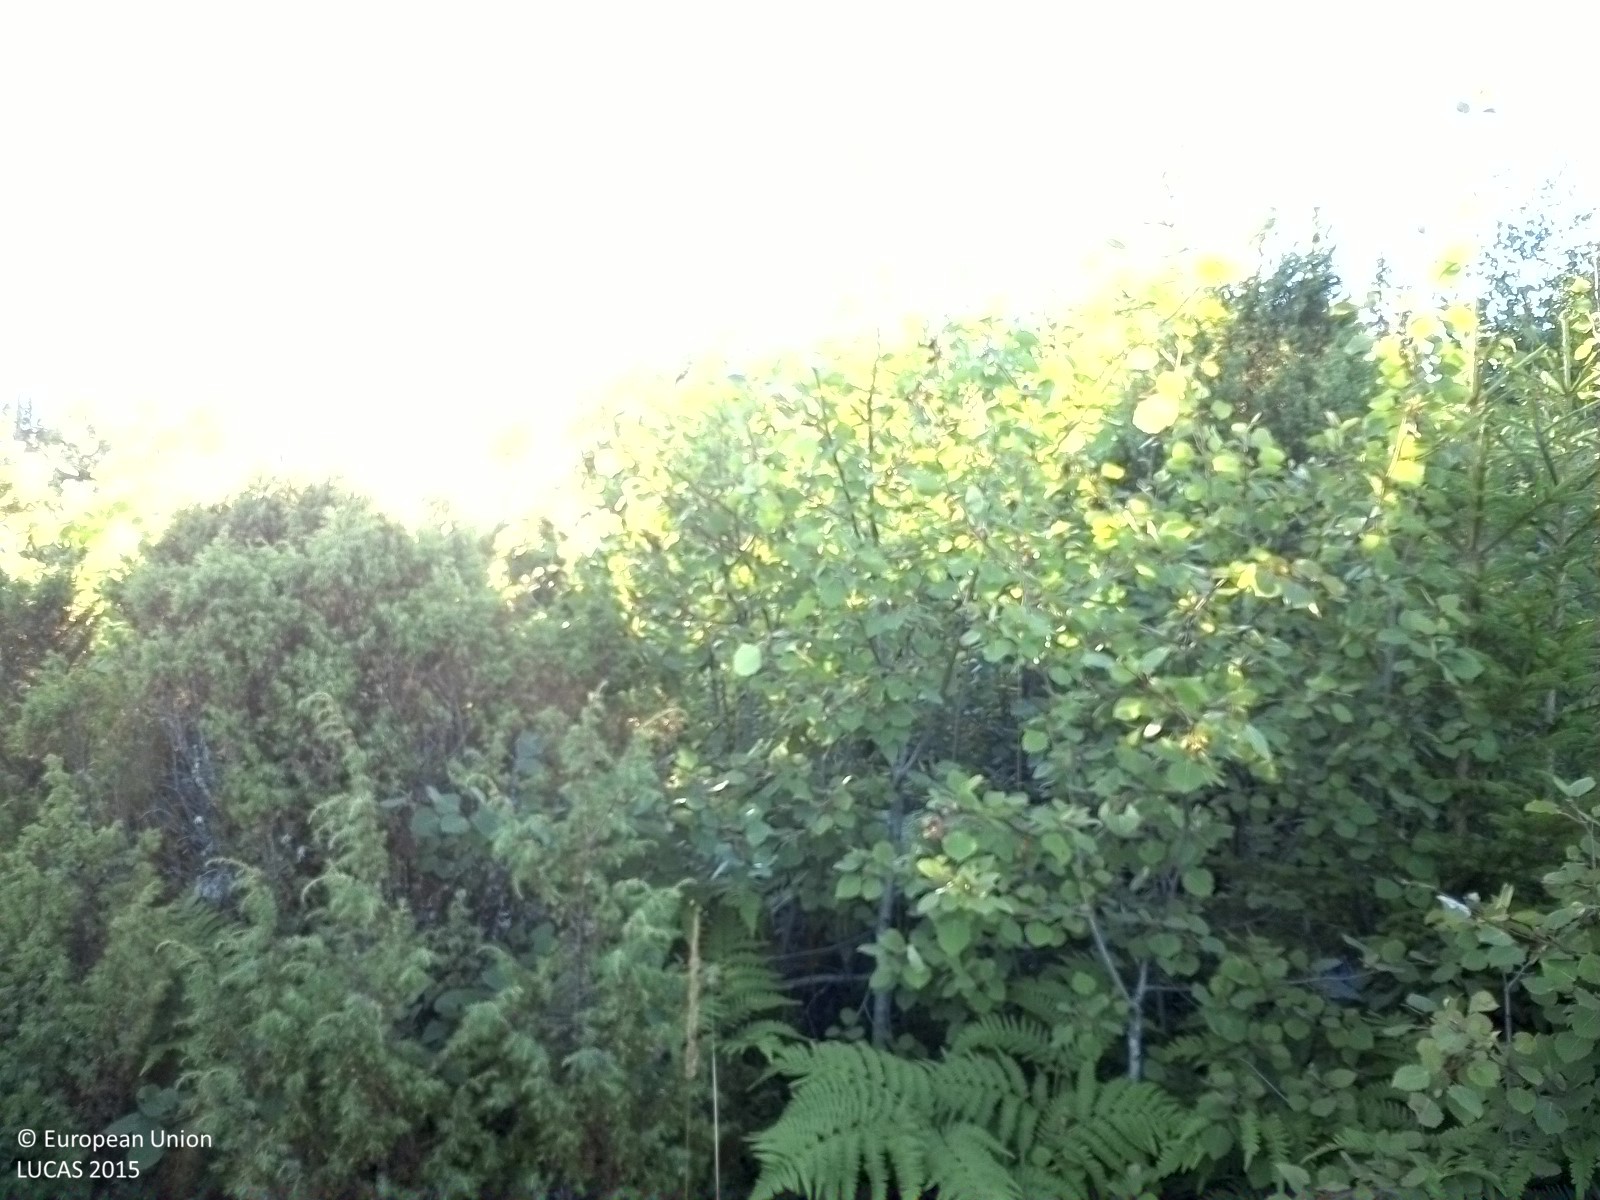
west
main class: Woodland
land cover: Pine dominated mixed woodland
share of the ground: 50 - 75 %
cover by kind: coniferous forest trees 35 %, shrubs 35 %, broadleaved forest trees 20 %, herbaceous plants 10 %
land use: Electricity, gas and thermal power distribution
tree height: < 5 m
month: August
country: SE
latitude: 62.3790
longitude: 16.9598
